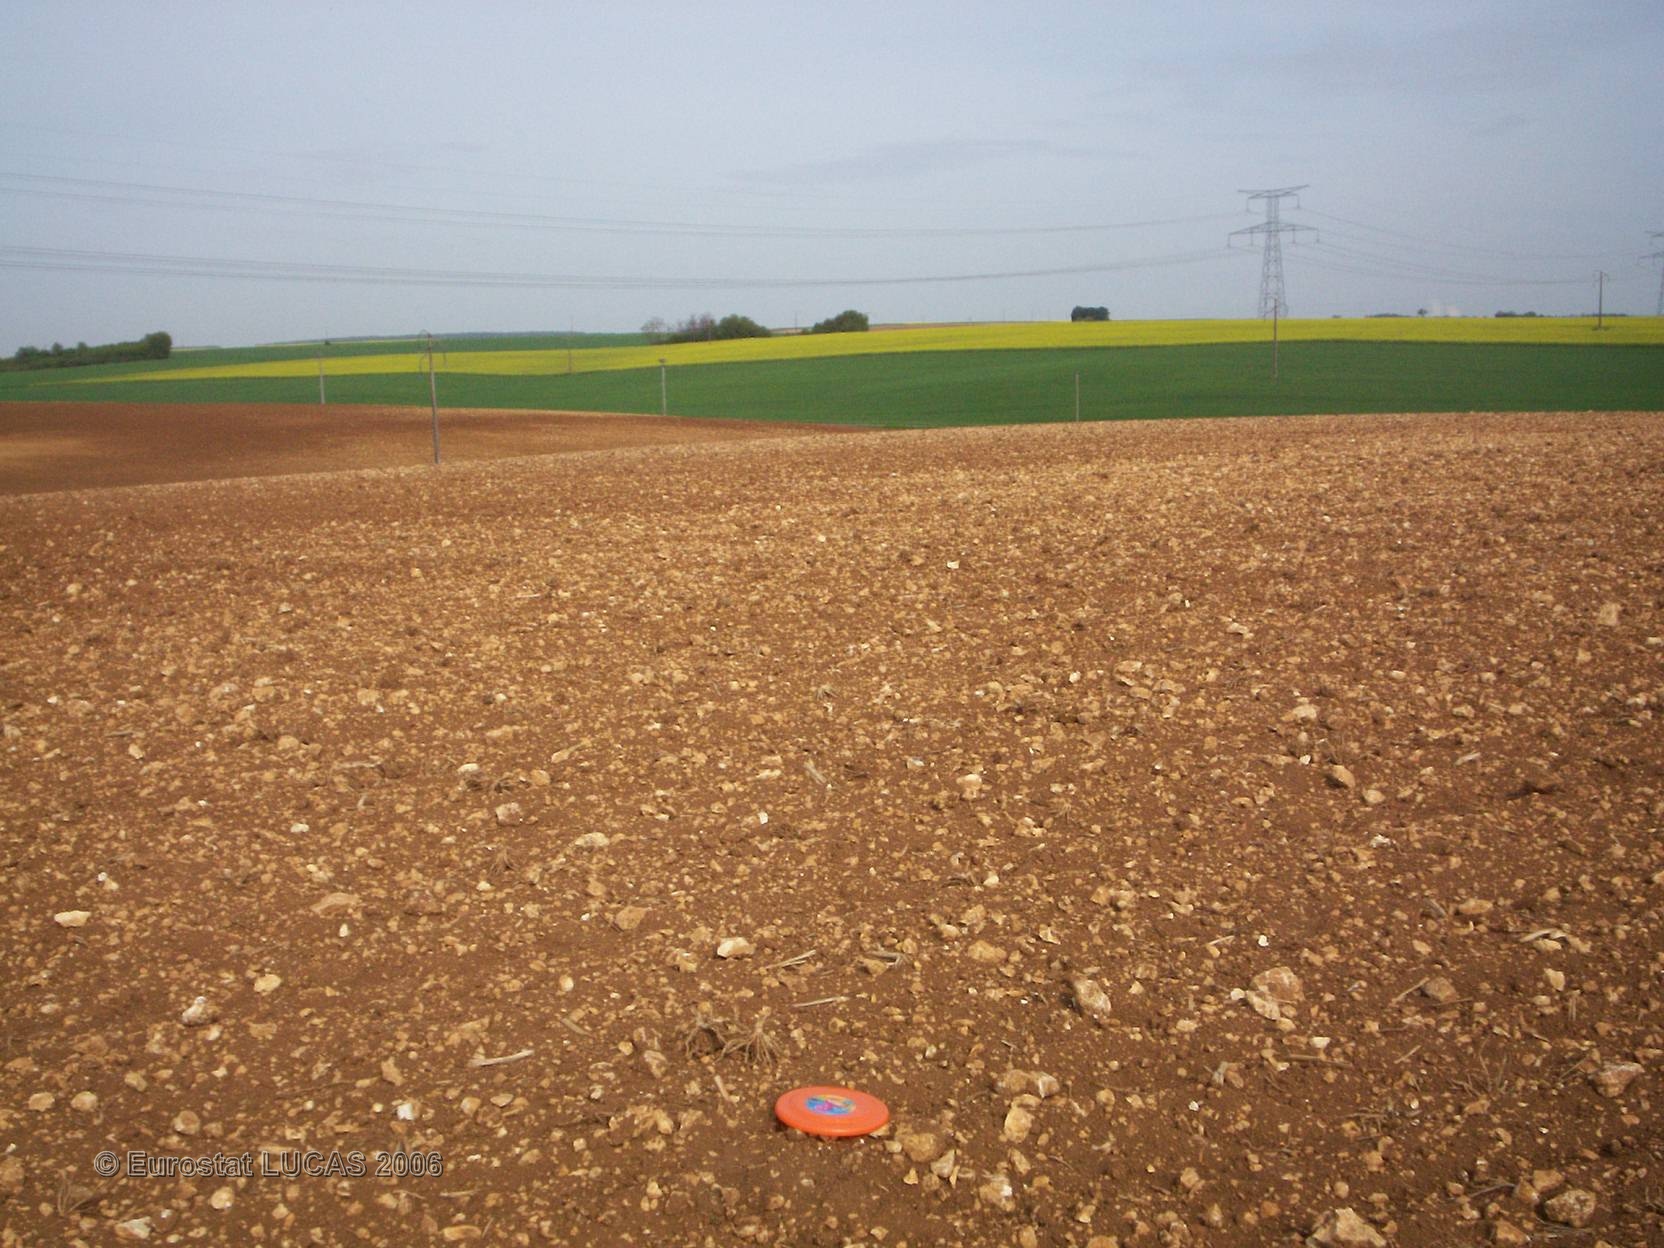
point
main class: Cropland
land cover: Sunflower
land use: Agriculture (excluding fallow land and kitchen gardens)
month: May
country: FR
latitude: 47.3160
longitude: 3.0231
